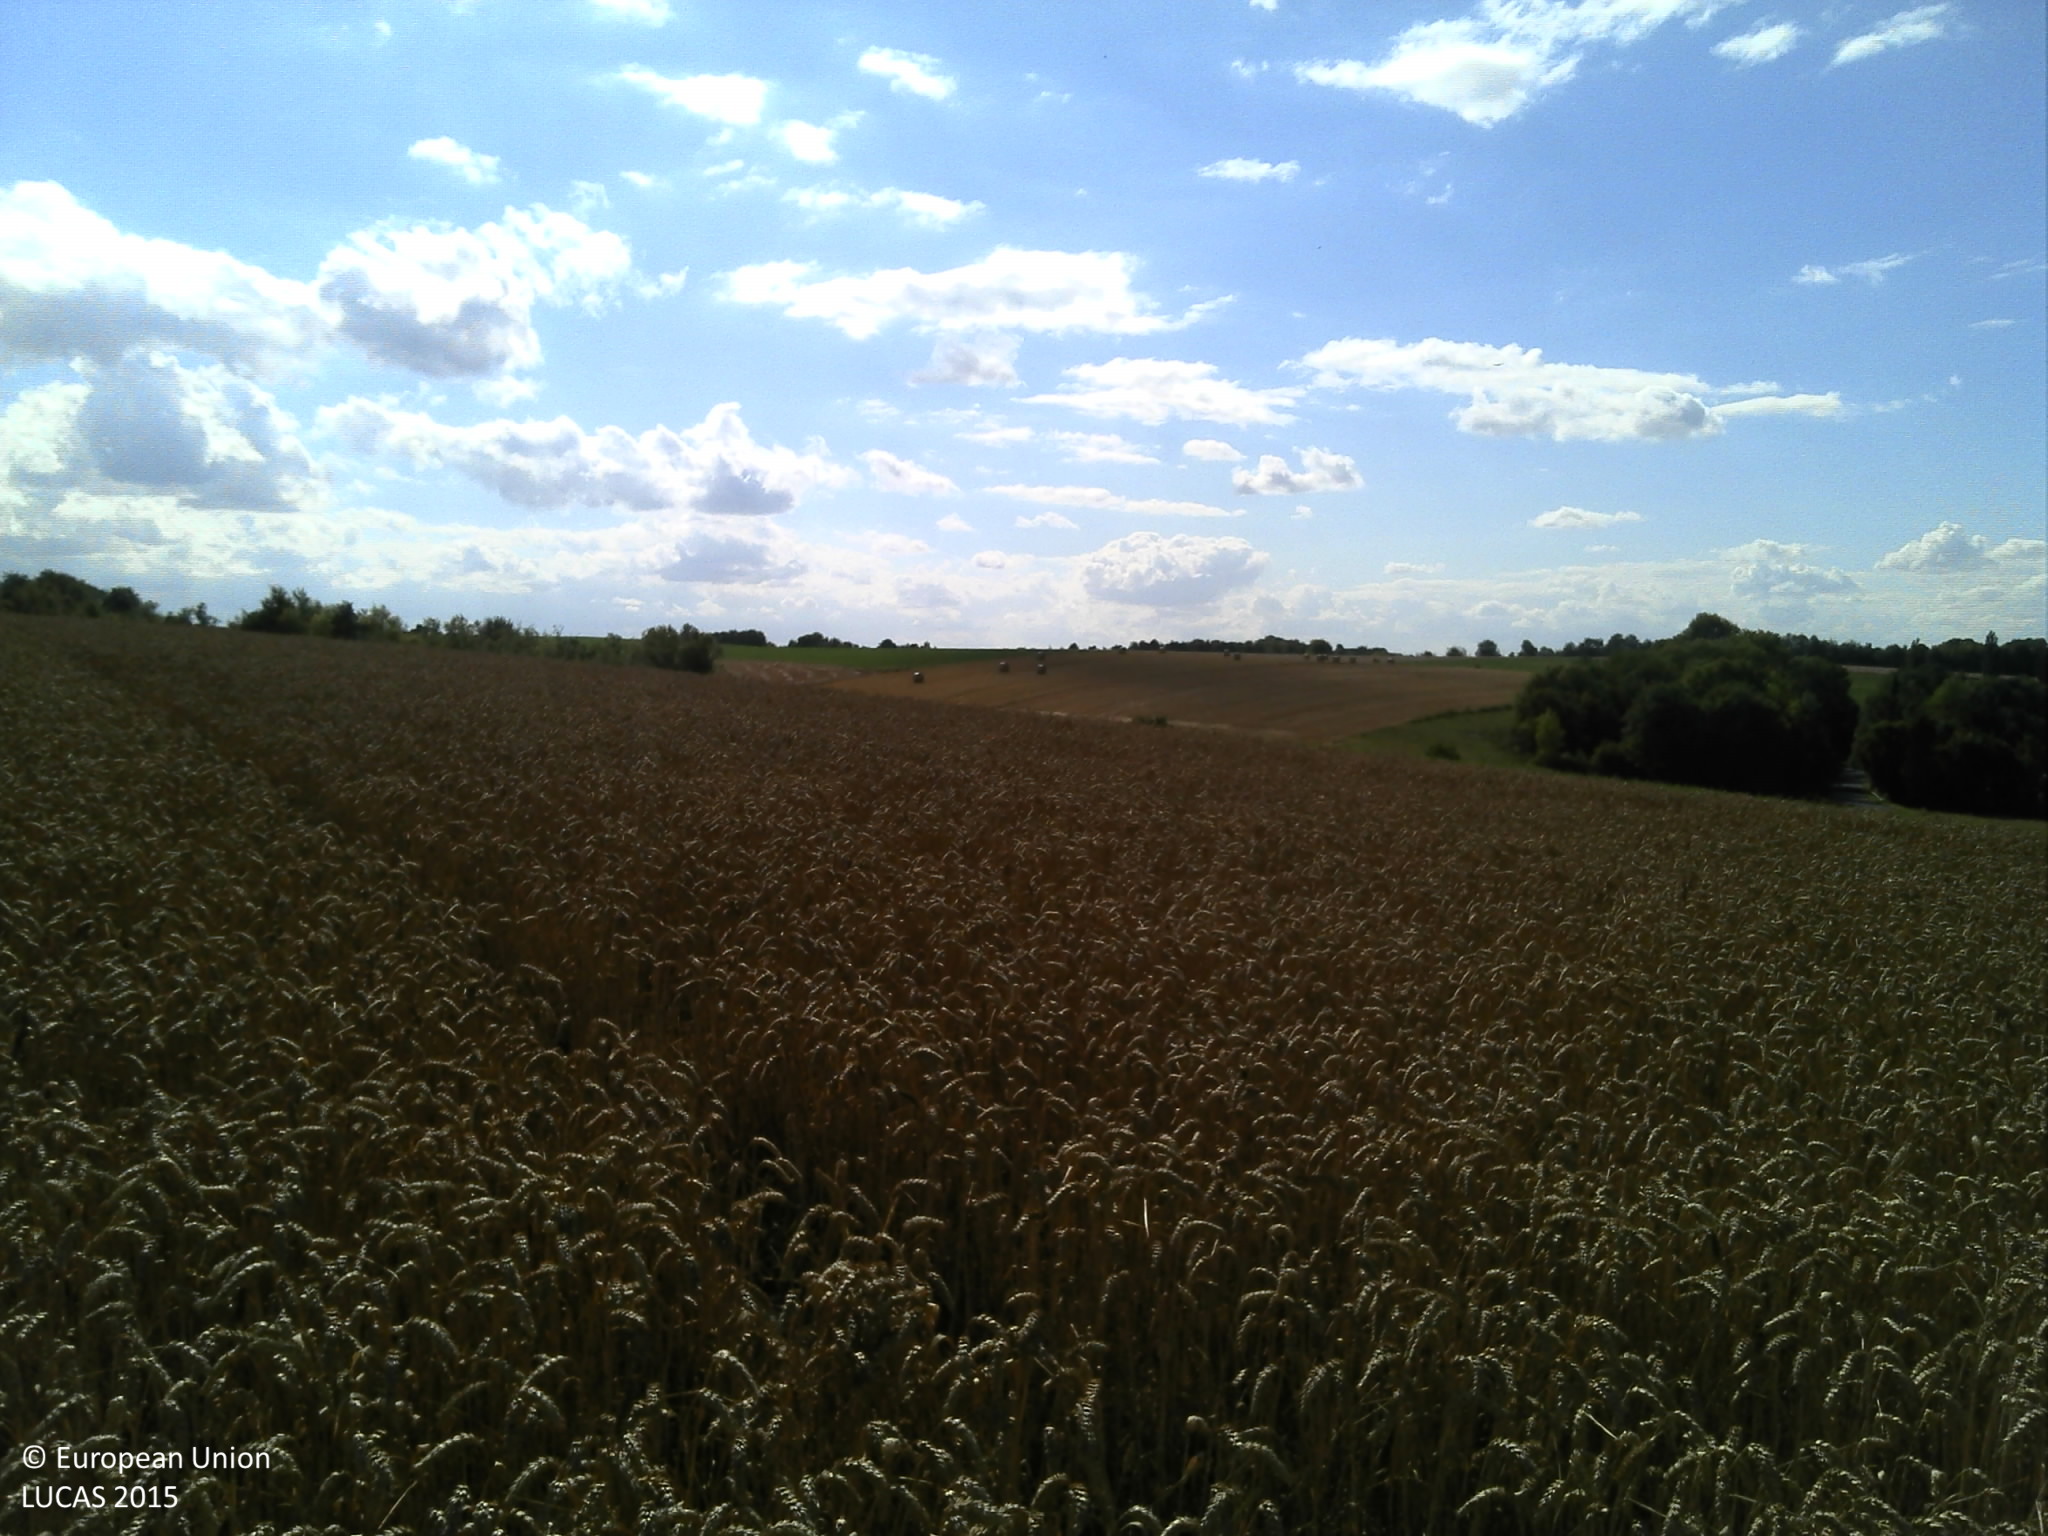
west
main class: Cropland
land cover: Common wheat
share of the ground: > 75 %
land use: Agriculture (excluding fallow land and kitchen gardens)
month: July
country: FR
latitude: 49.2657
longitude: 4.6511
